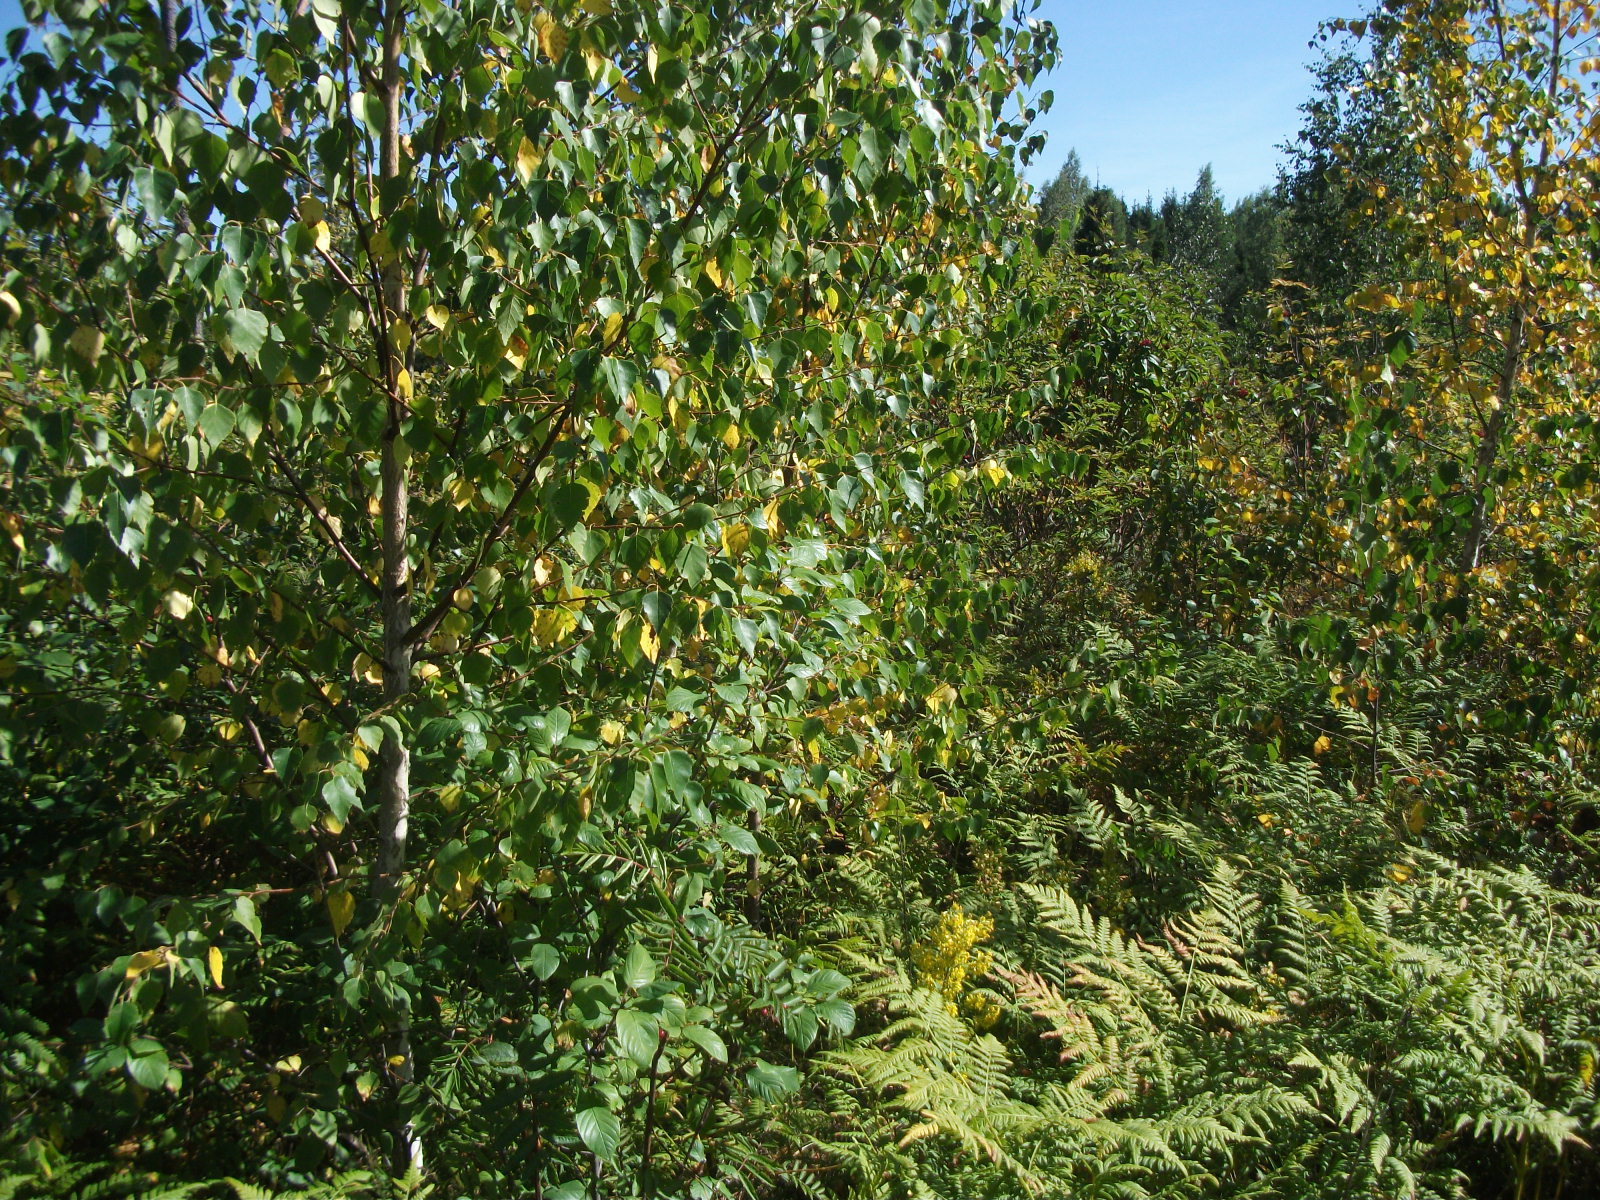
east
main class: Woodland
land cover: Broadleaved woodland
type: non-riverine alder, birch or aspen forest
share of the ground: 50 - 75 %
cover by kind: broadleaved forest trees 50 %, shrubs 30 %, herbaceous plants 15 %, coniferous forest trees 5 %
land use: Forestry
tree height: < 5 m
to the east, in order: Broadleaved woodland; Shrubland without tree cover; Spruce dominated coniferous woodland; Pine dominated coniferous woodland; Grassland with sparse tree/shrub cover
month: August
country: LV
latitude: 56.4888
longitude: 26.0674
